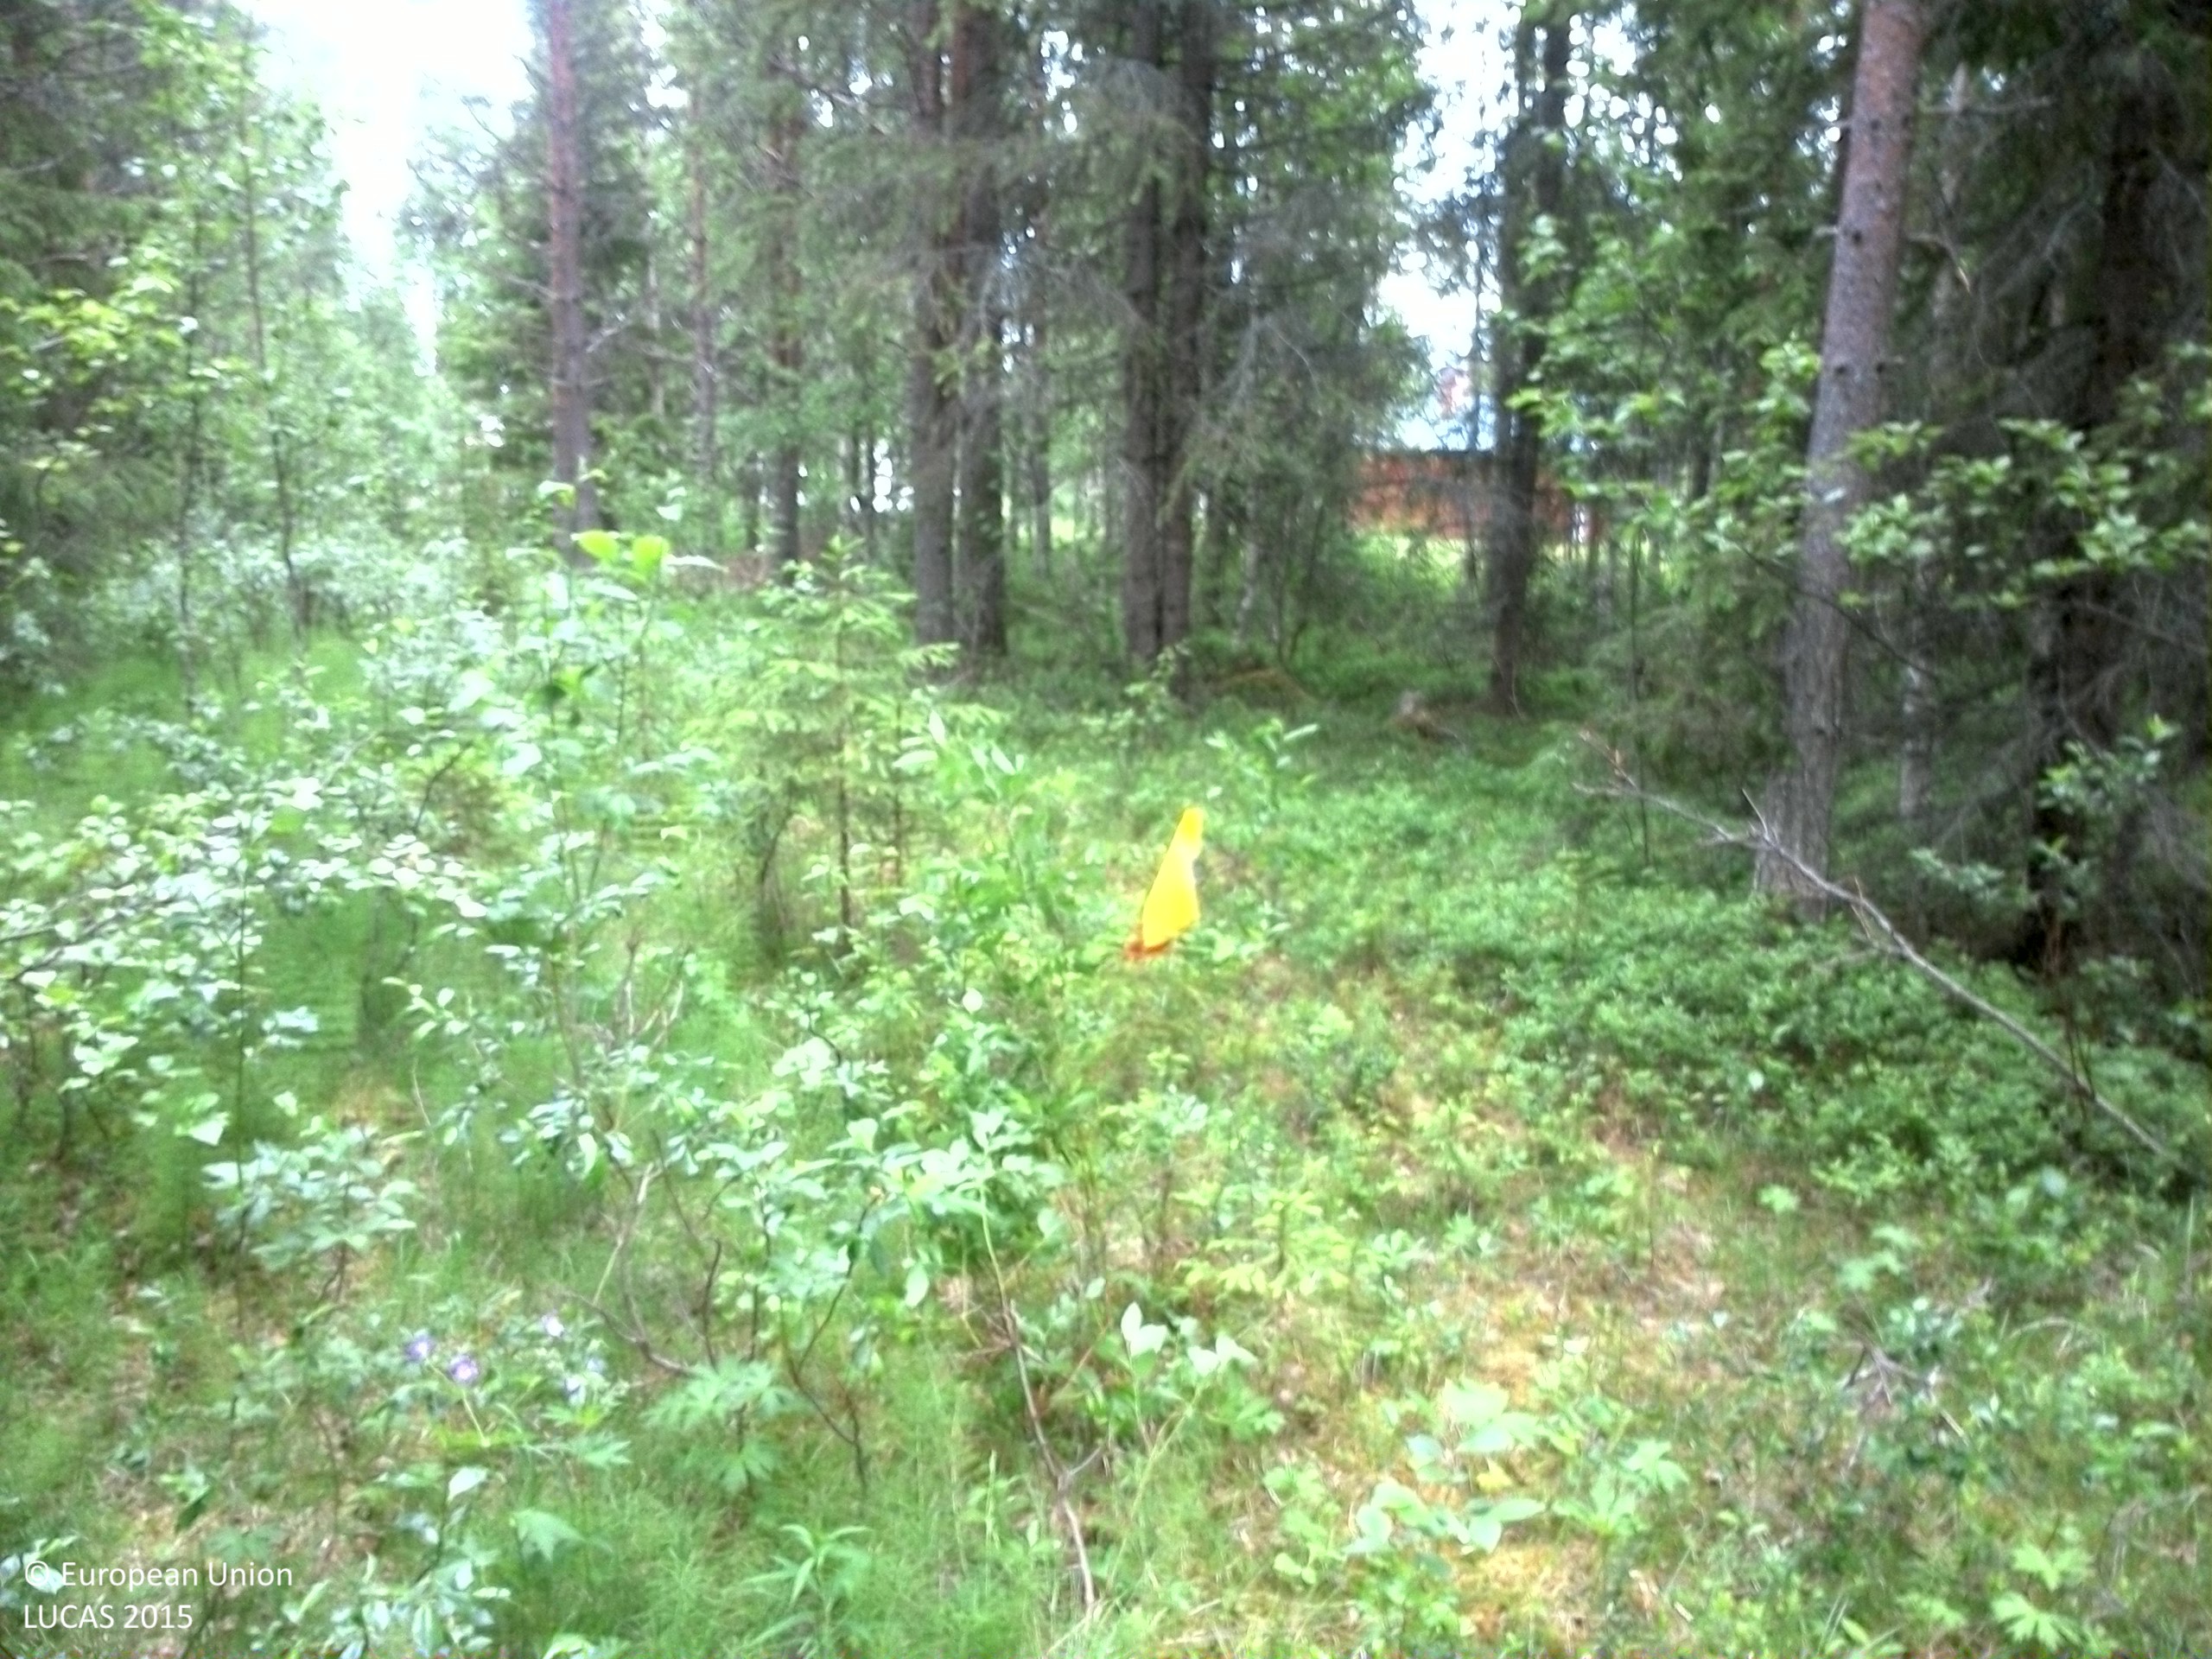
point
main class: Woodland
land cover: Other mixed woodland
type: boreal forest
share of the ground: 50 - 75 %
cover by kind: coniferous forest trees 45 %, shrubs 25 %, broadleaved forest trees 15 %, lichens and mosses 10 %, herbaceous plants 5 %
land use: Forestry
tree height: > 5 m
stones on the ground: 10 - 25 %
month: July
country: SE
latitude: 64.4096
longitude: 16.0490
